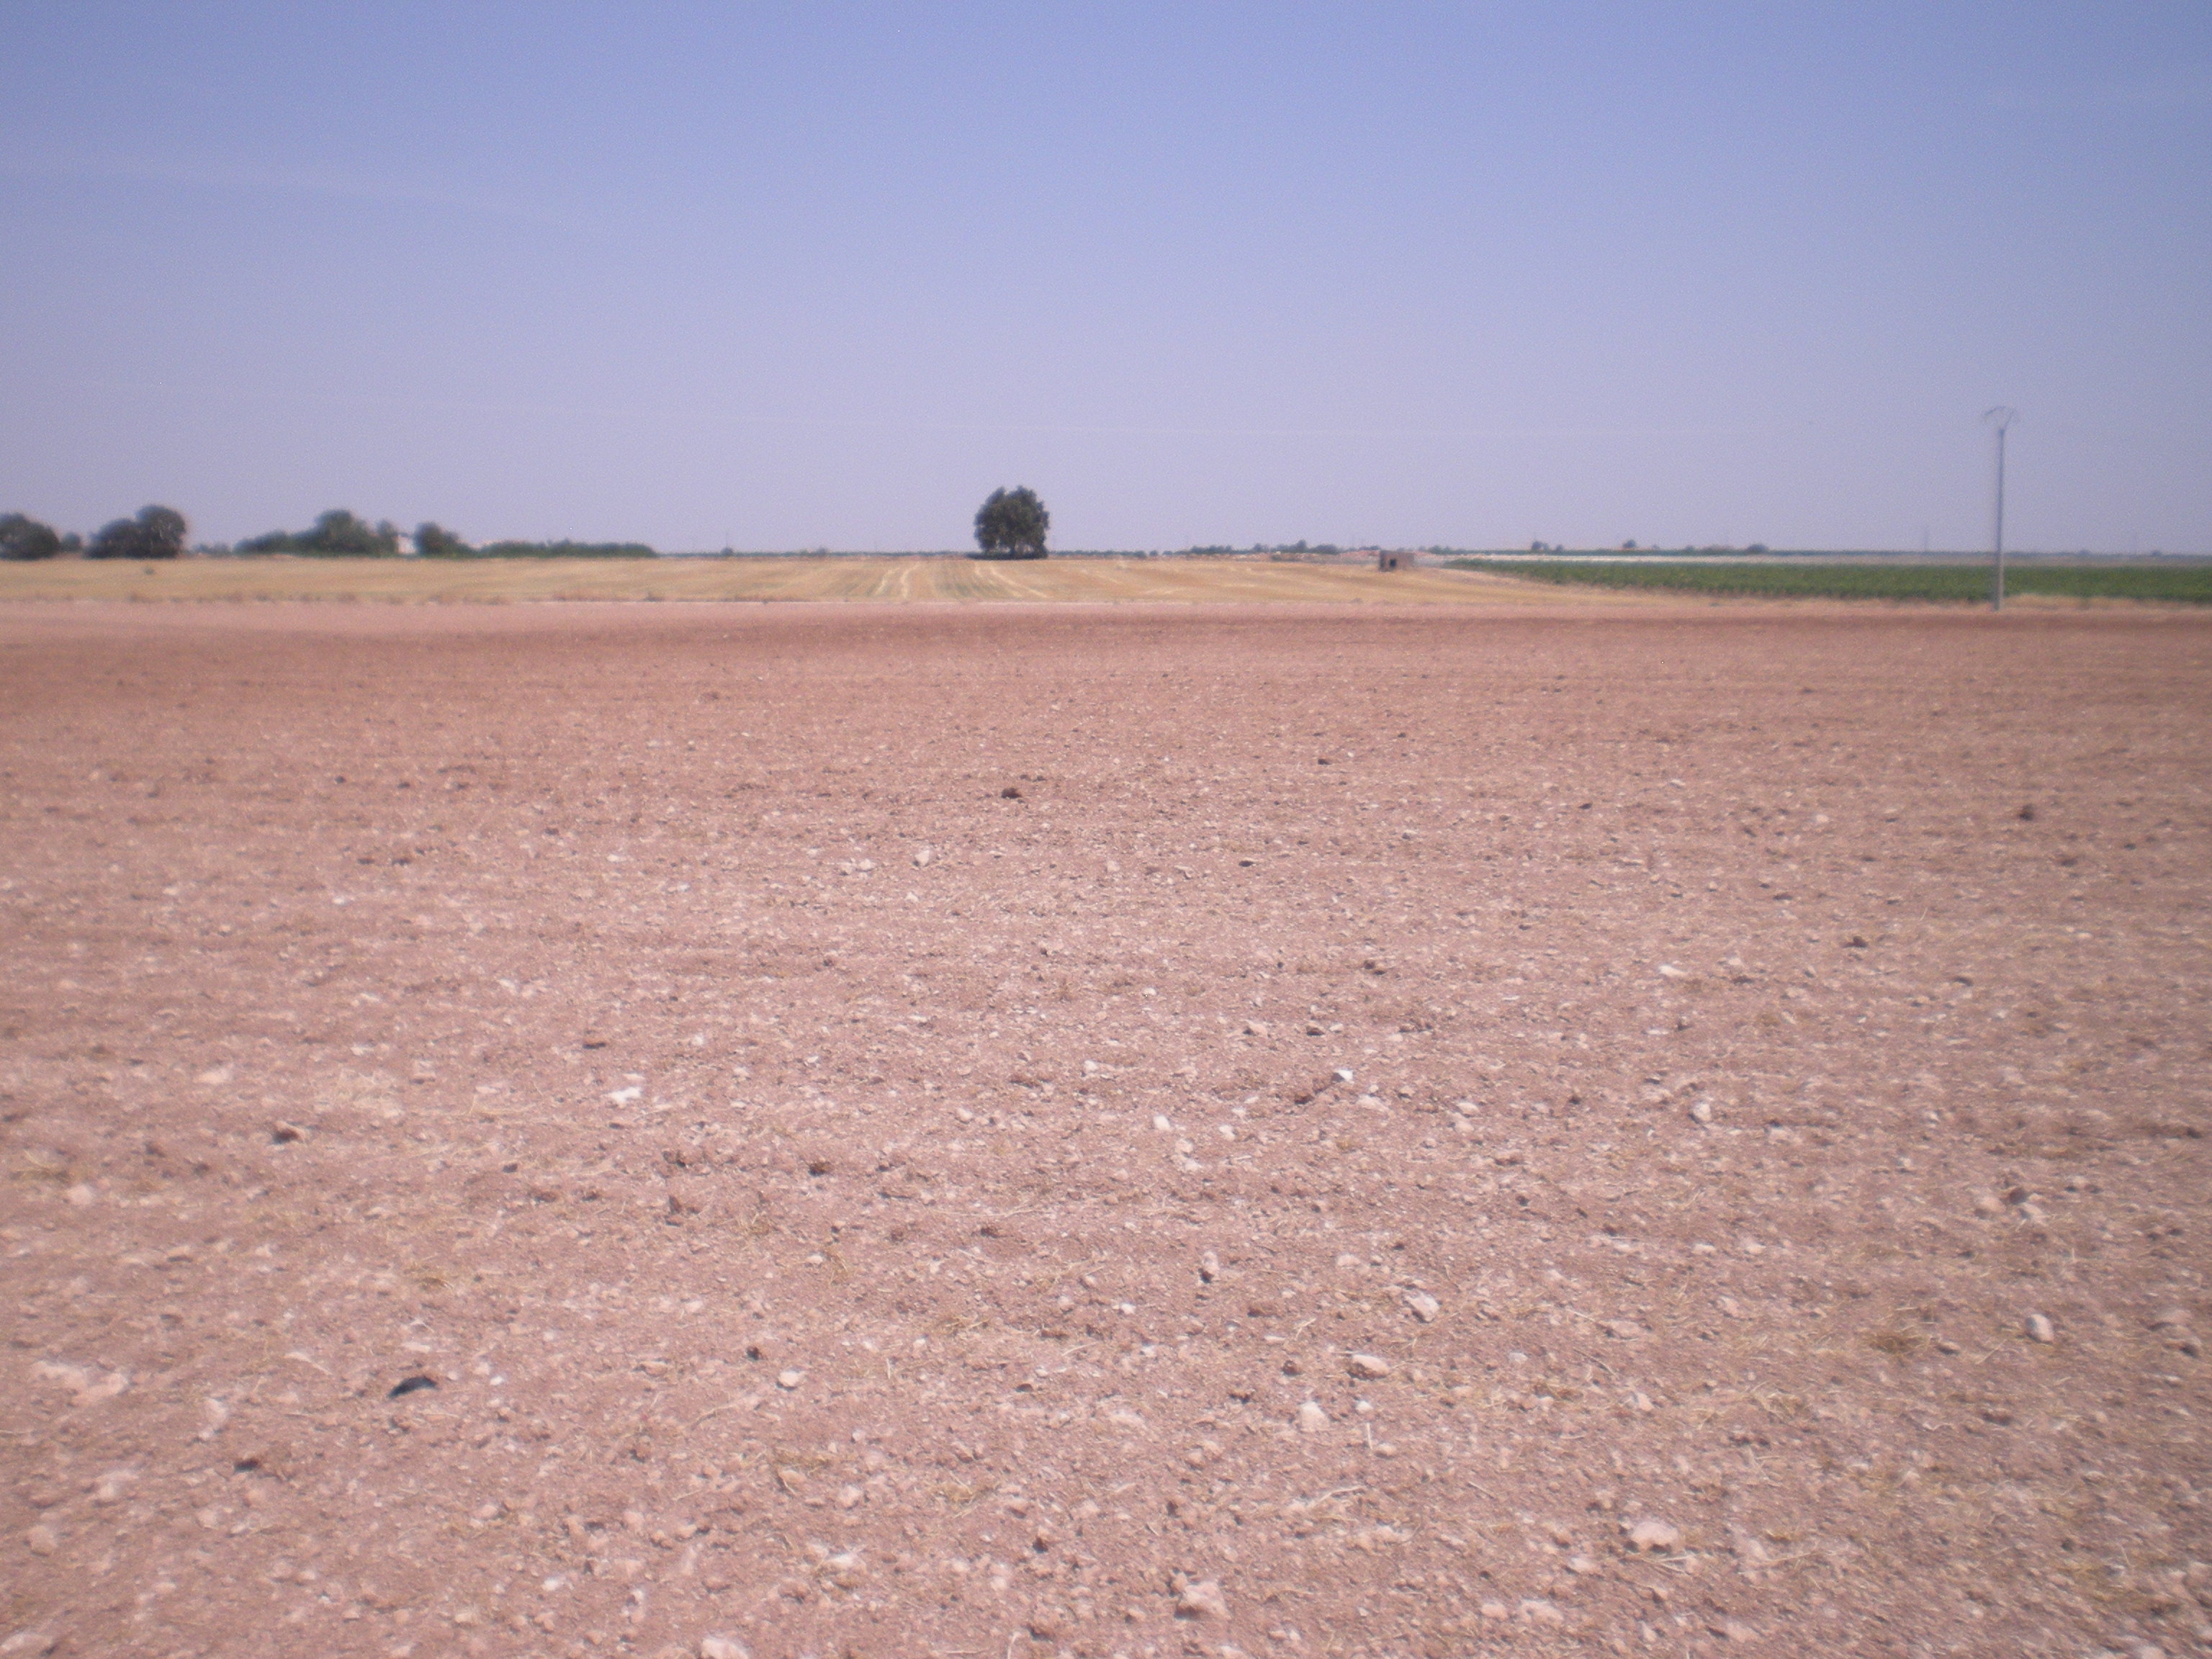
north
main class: Cropland
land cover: Dry pulses
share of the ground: < 10 %
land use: Agriculture (excluding fallow land and kitchen gardens)
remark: Harvested field
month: July
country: ES
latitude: 39.2350
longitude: -3.2580
